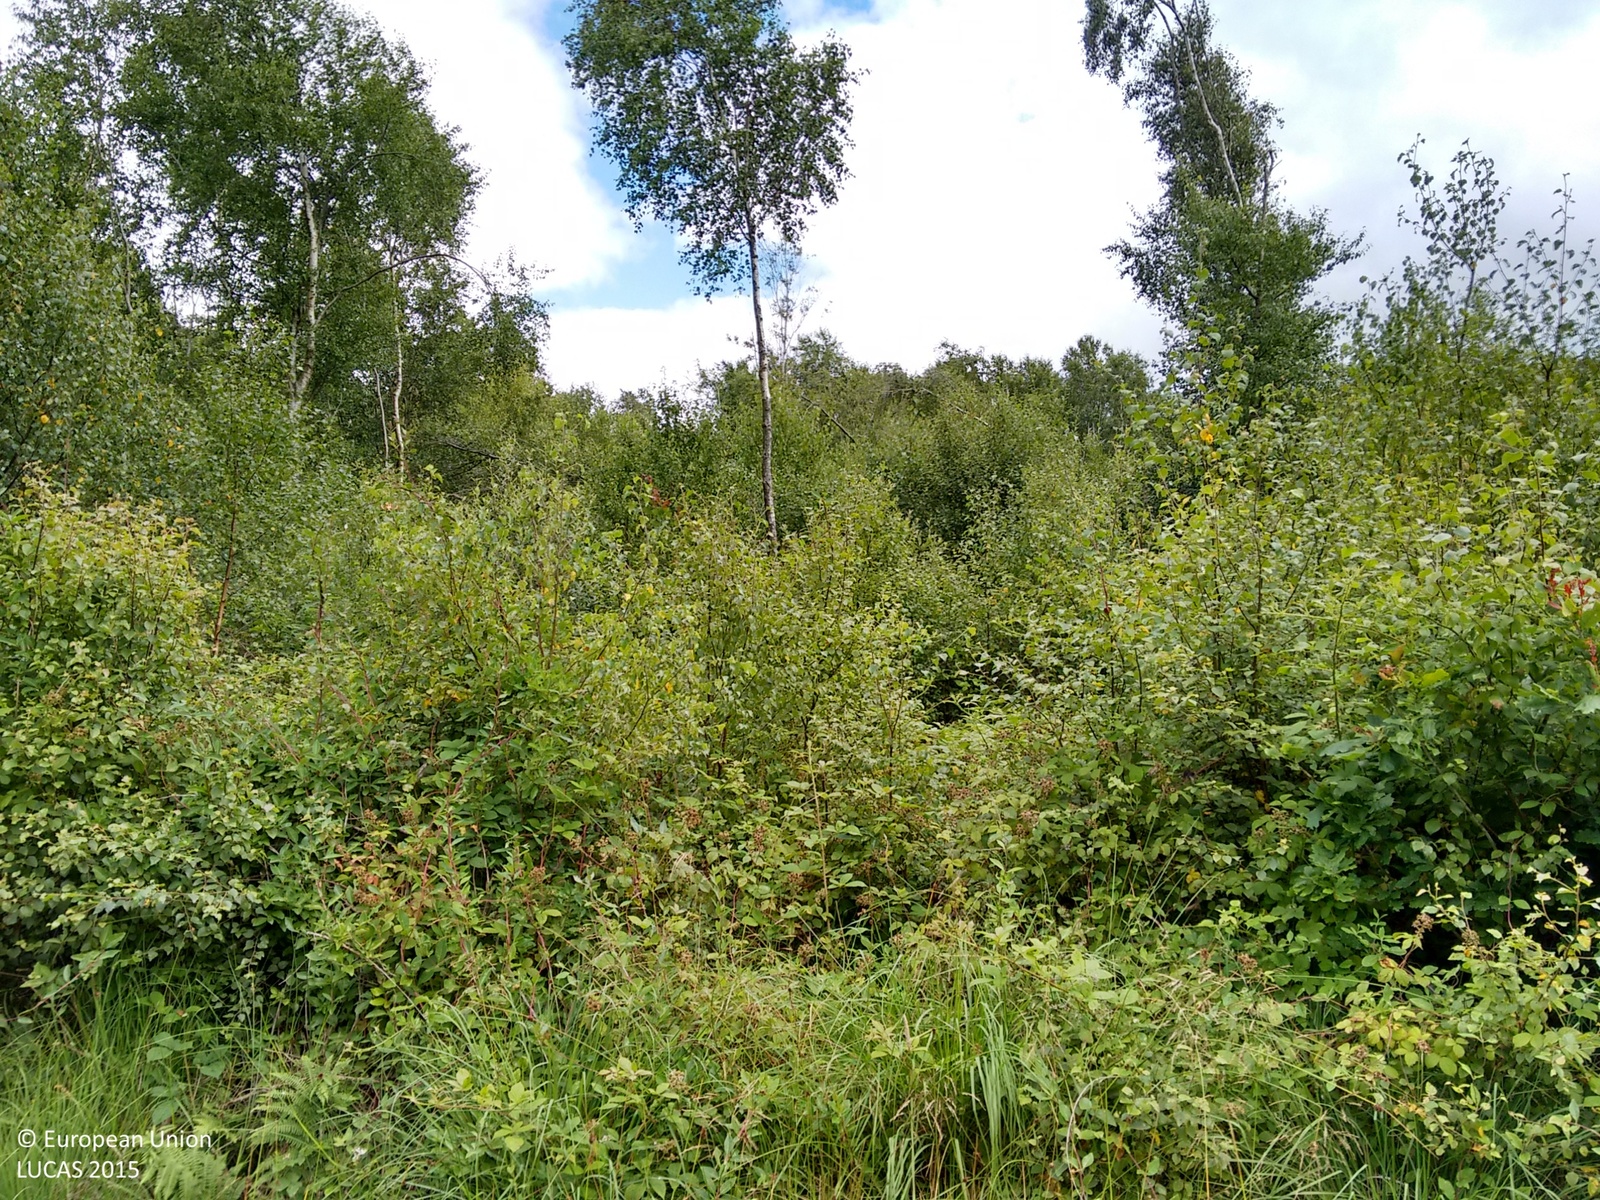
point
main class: Woodland
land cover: Broadleaved woodland
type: mesophytic deciduous forest
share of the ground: > 75 %
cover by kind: broadleaved forest trees 80 %, shrubs 20 %
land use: Forestry
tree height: > 5 m
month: July
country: GB
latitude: 51.6889
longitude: -3.9959
